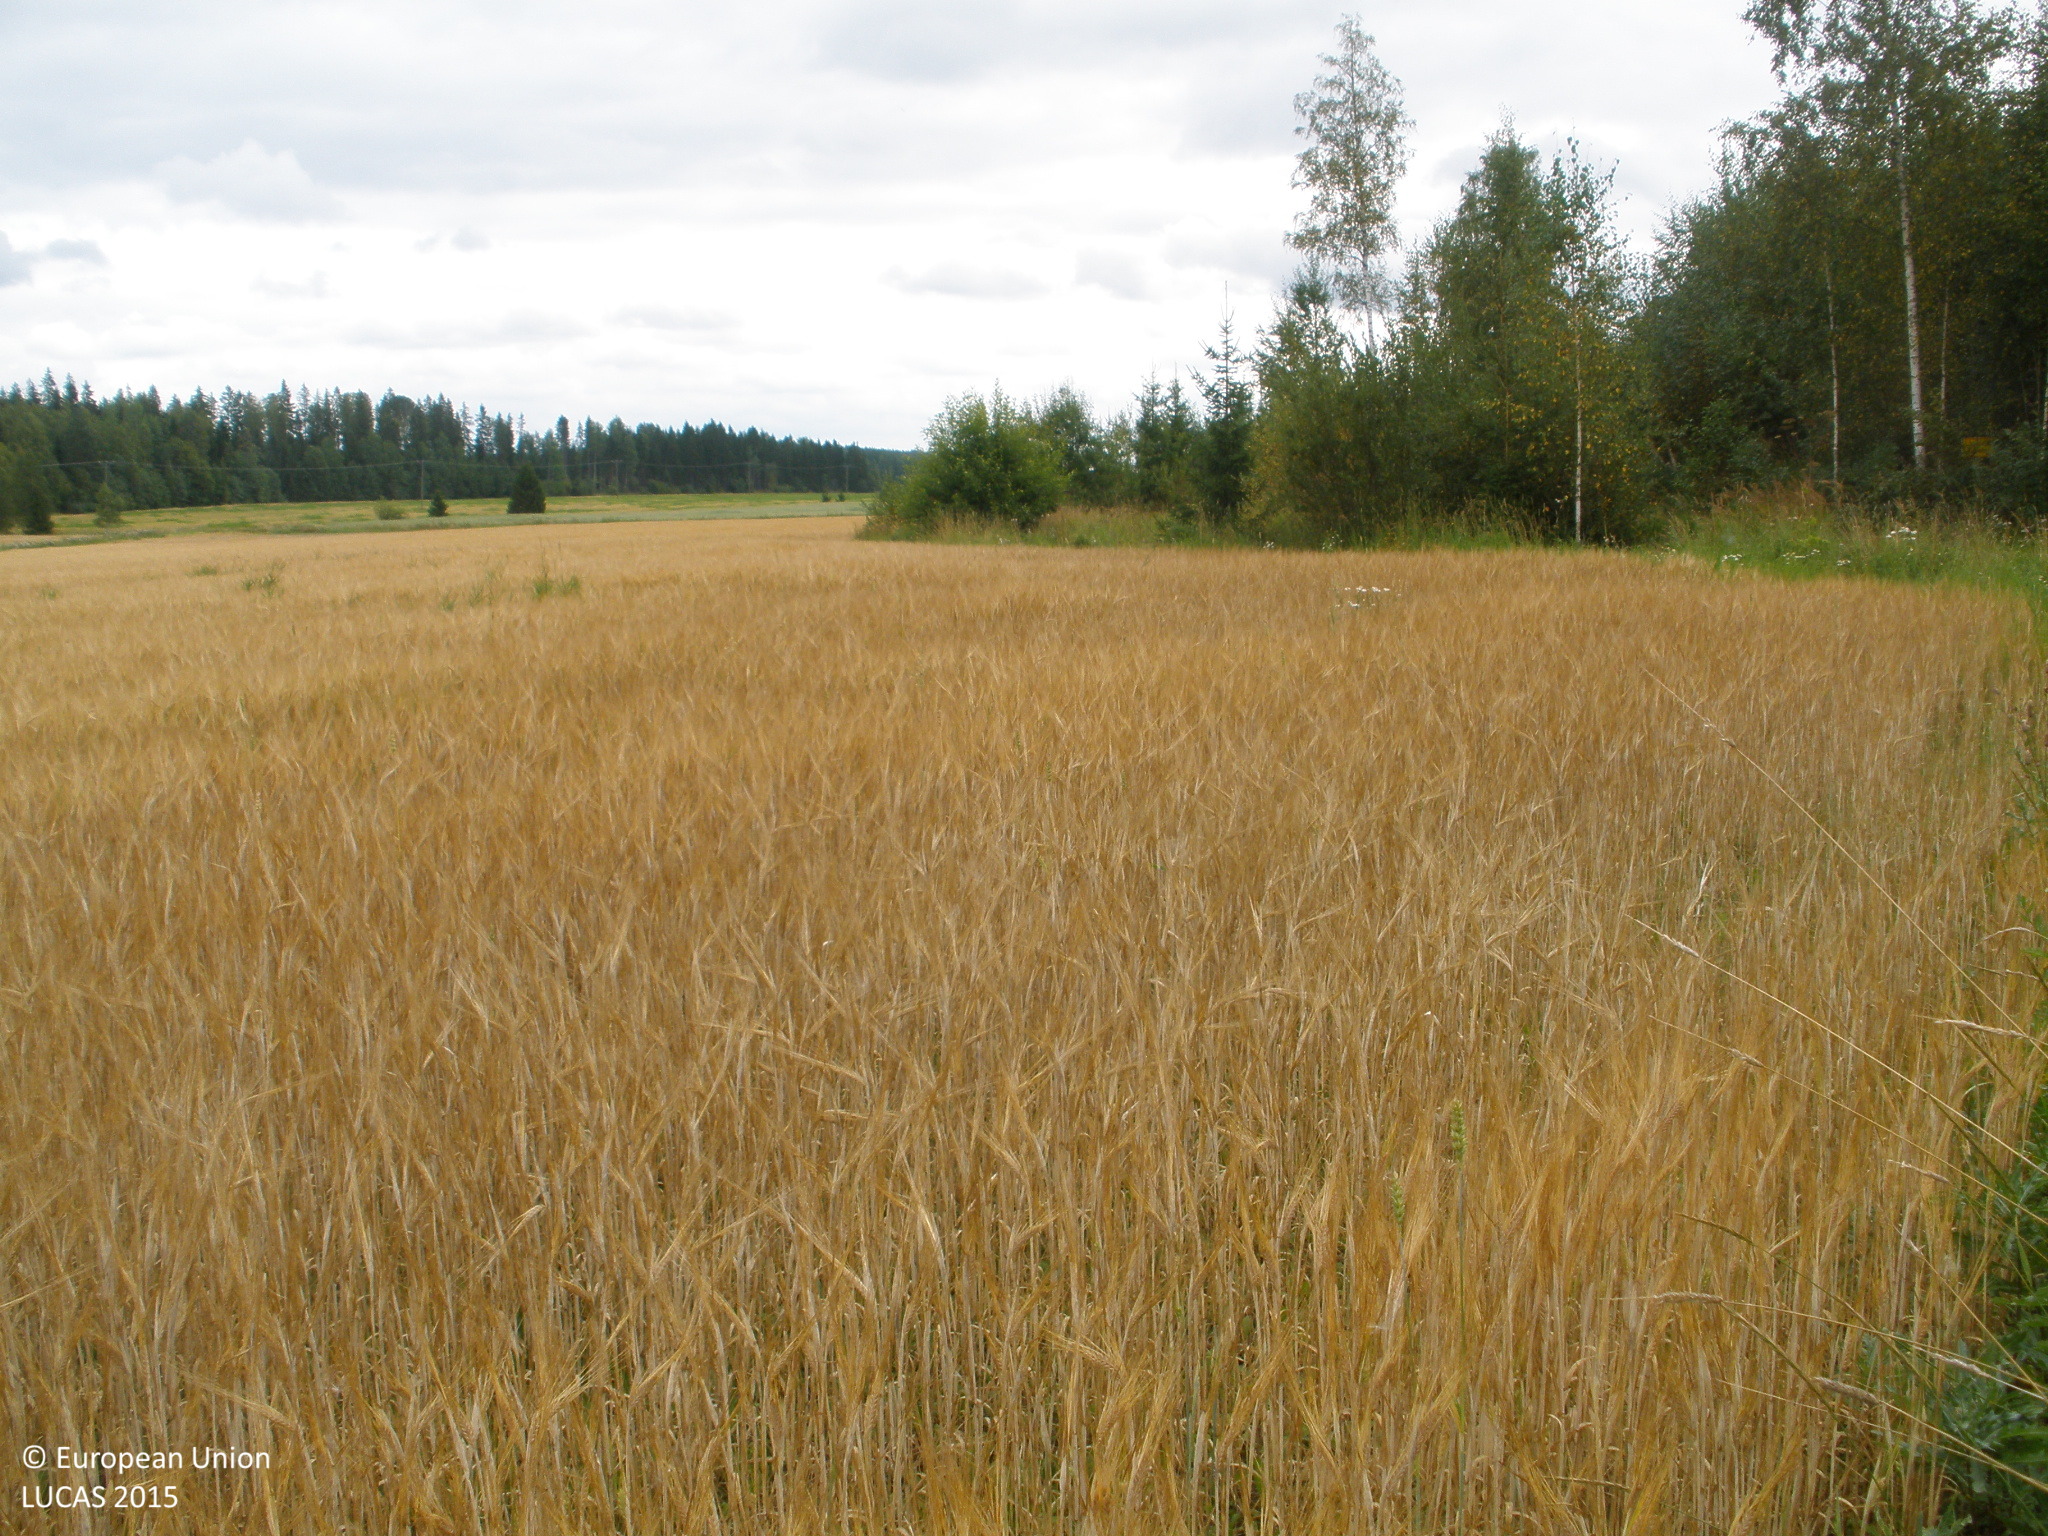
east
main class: Cropland
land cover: Barley
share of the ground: > 75 %
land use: Agriculture (excluding fallow land and kitchen gardens)
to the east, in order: Barley; Grass margins; Ditches and canals; Grass margins; Oats
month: August
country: FI
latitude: 60.5822
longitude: 23.5755
